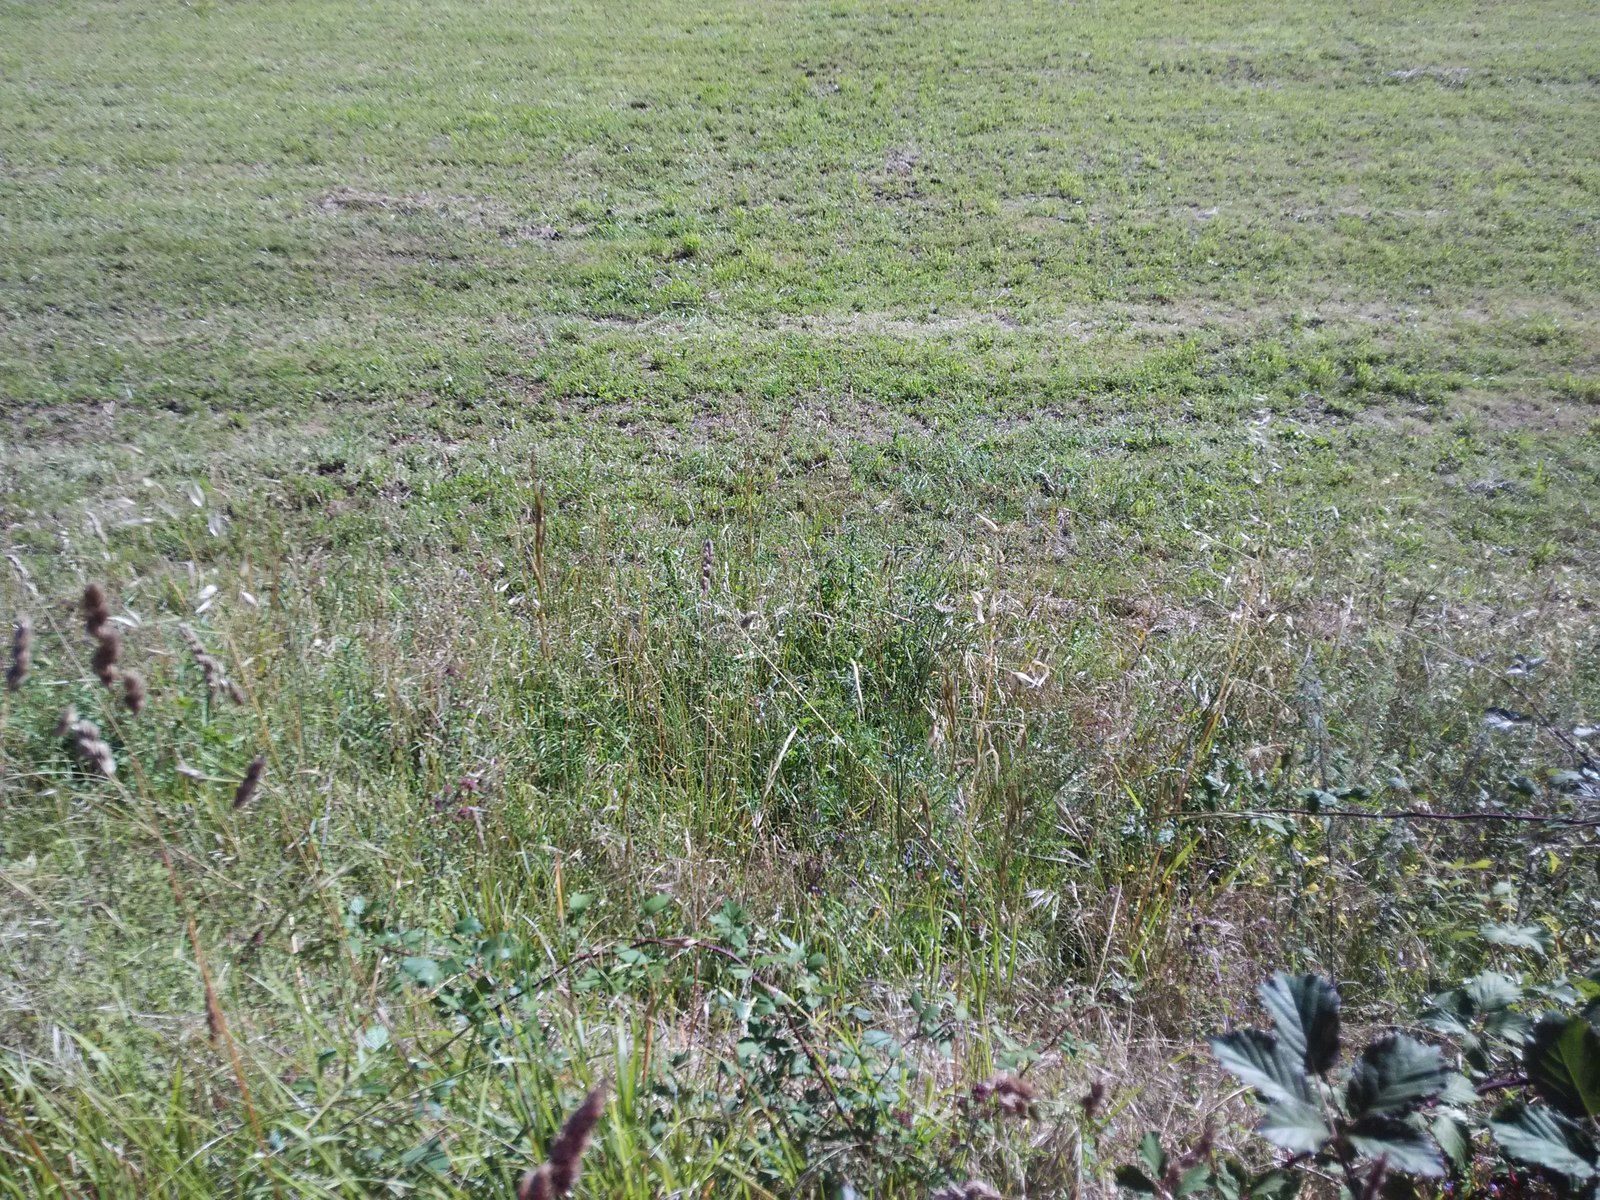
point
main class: Grassland
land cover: Grassland without tree/shrub cover
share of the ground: > 75 %
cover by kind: herbaceous plants 85 %, shrubs 5 %
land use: Agriculture (excluding fallow land and kitchen gardens)
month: June
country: ES
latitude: 43.3390
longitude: -2.6244
